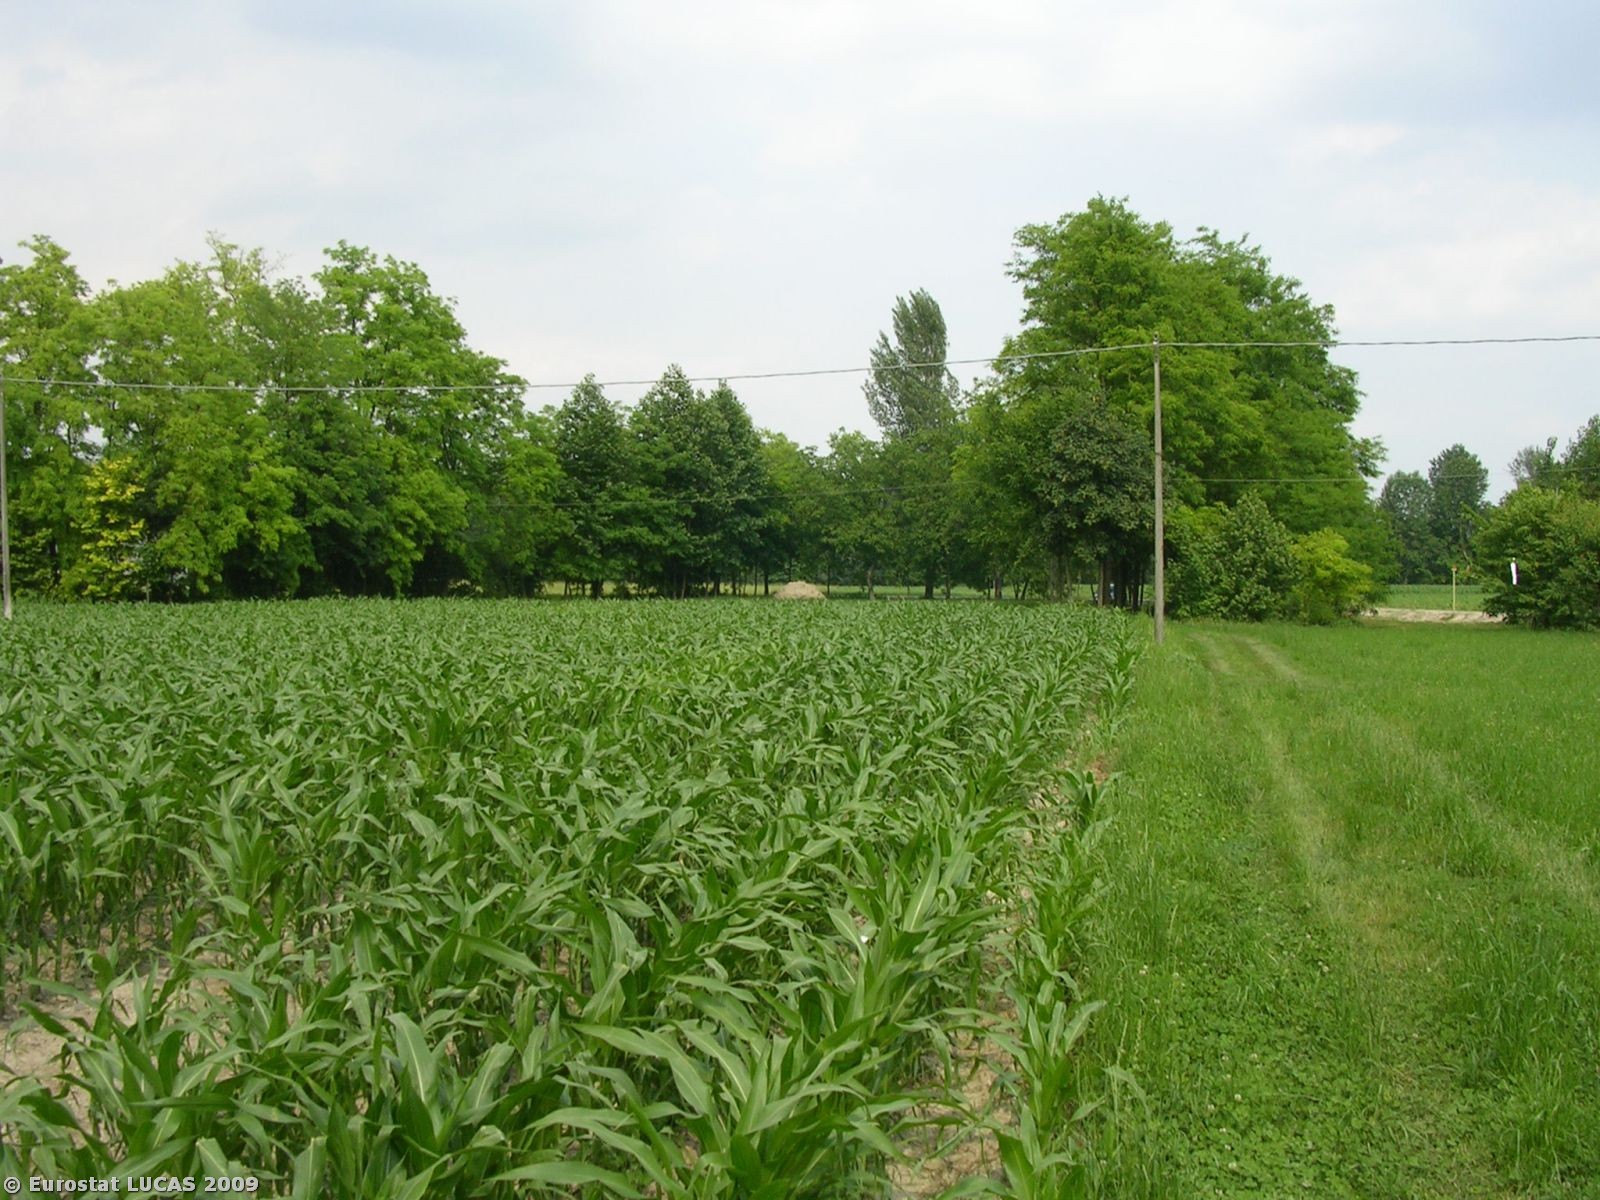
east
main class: Cropland
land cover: Maize
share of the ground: > 75 %
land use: Agriculture (excluding fallow land and kitchen gardens)
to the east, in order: Maize; Electric lines; Maize; Broadleaved woodland; Paved roads, cycling and walking lanes; Grassland without tree/shrub cover; Managed hedges; Maize
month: June
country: IT
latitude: 45.6160
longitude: 11.7541
